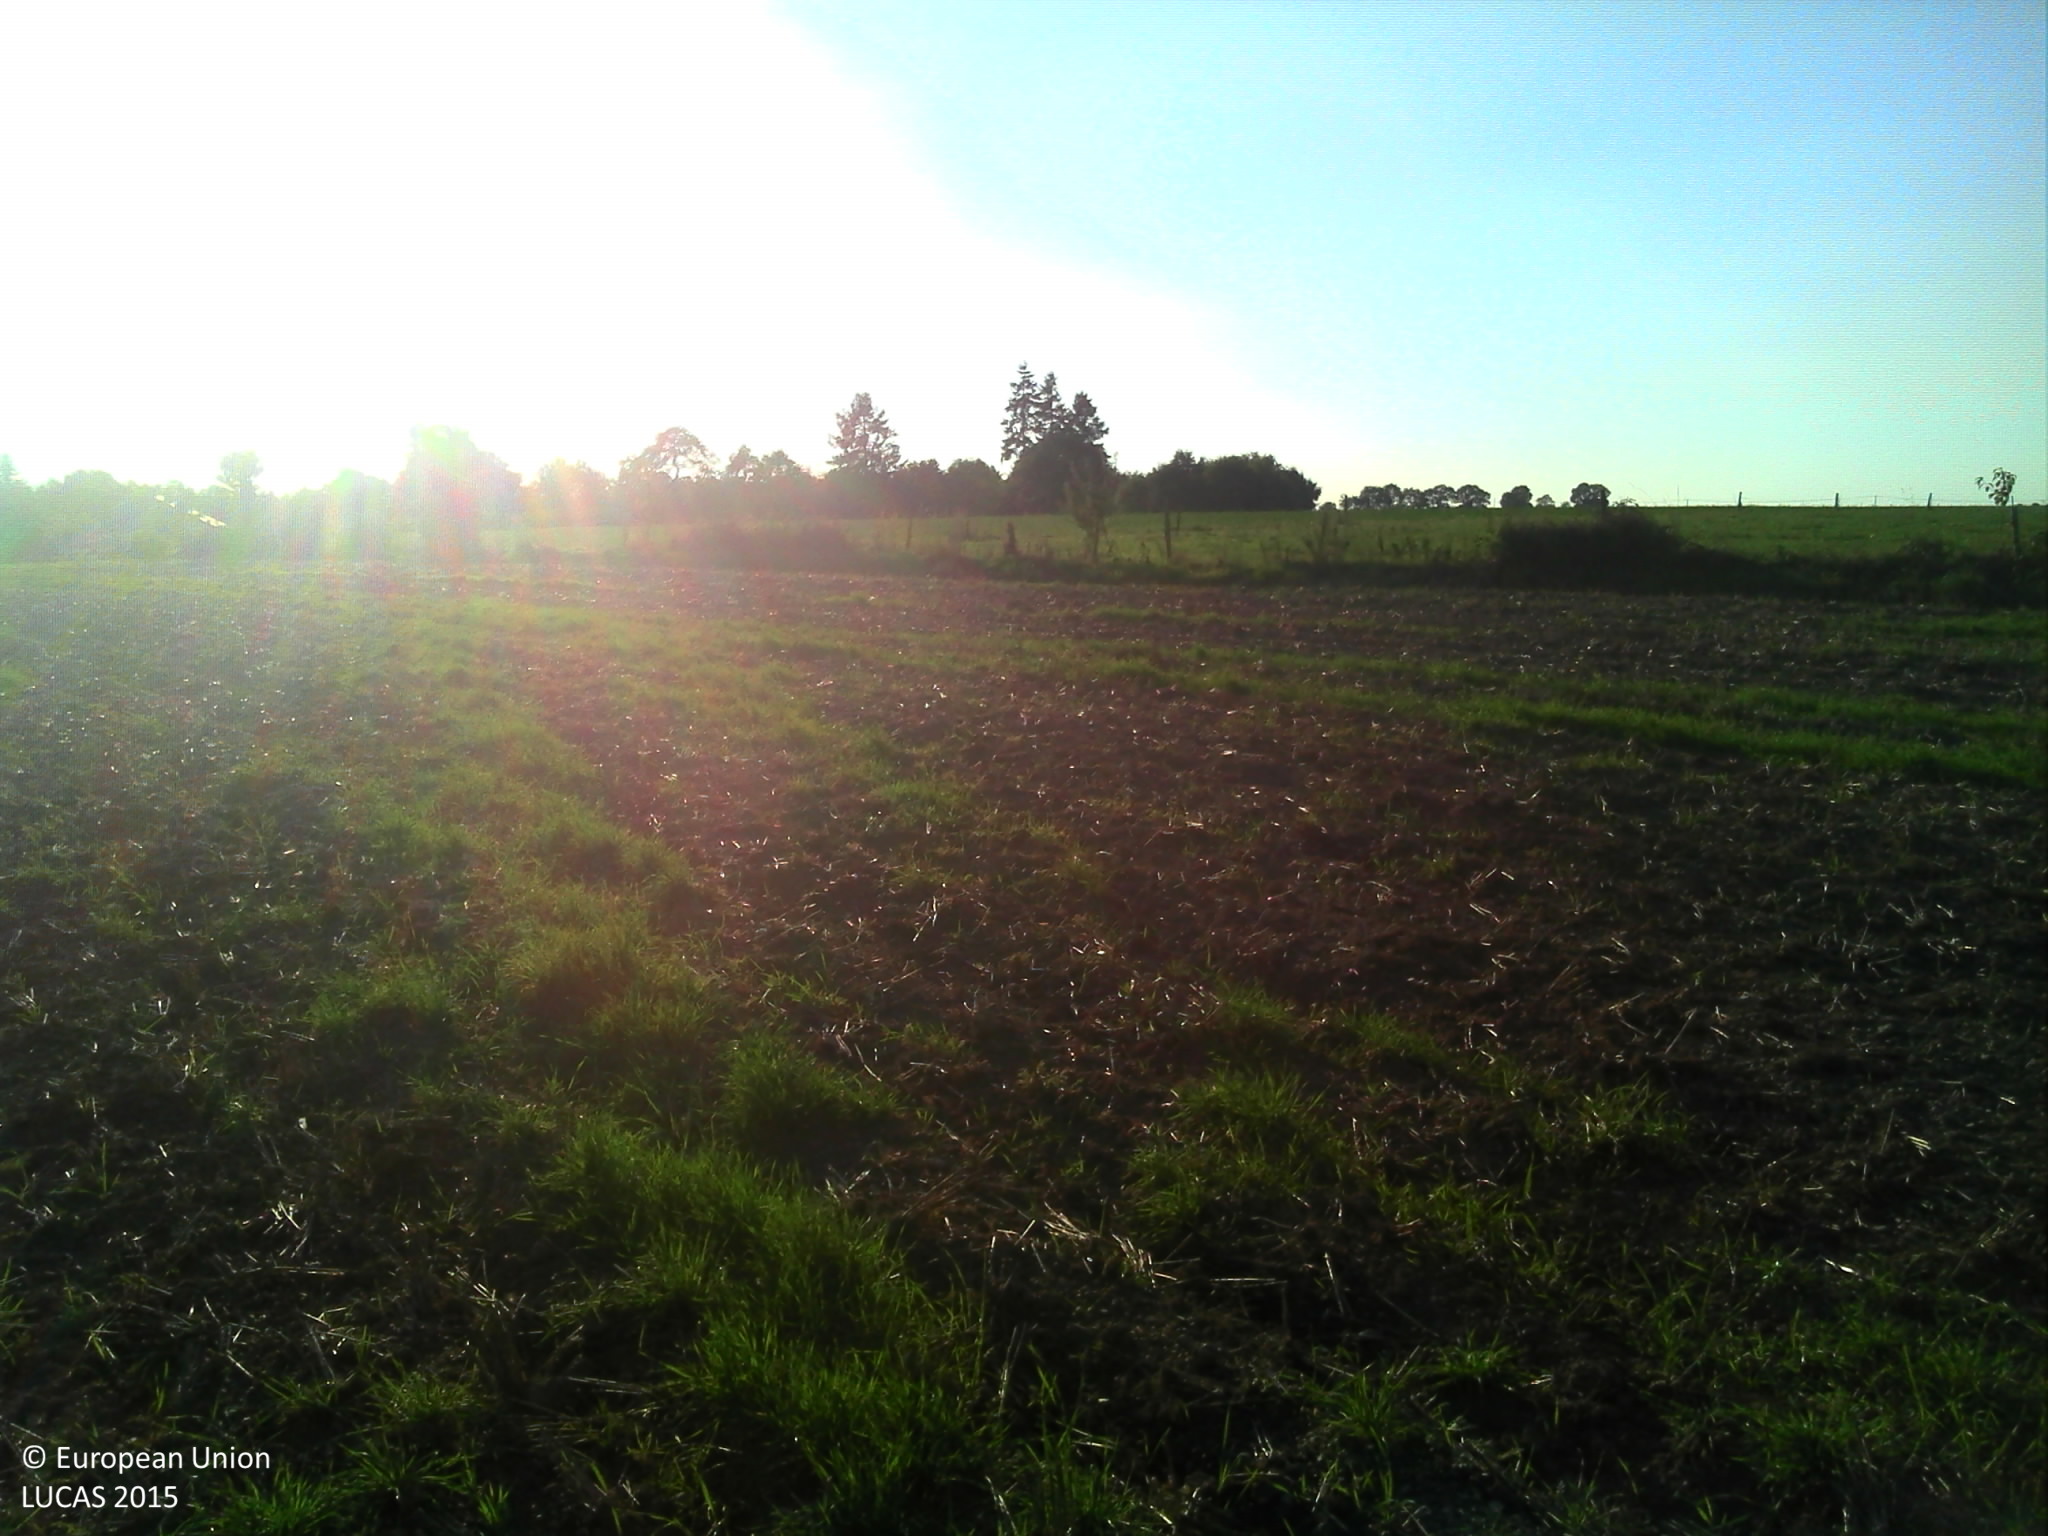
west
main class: Cropland
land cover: Common wheat
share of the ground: > 75 %
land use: Agriculture (excluding fallow land and kitchen gardens)
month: June
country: FR
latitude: 48.0473
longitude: -1.4065
